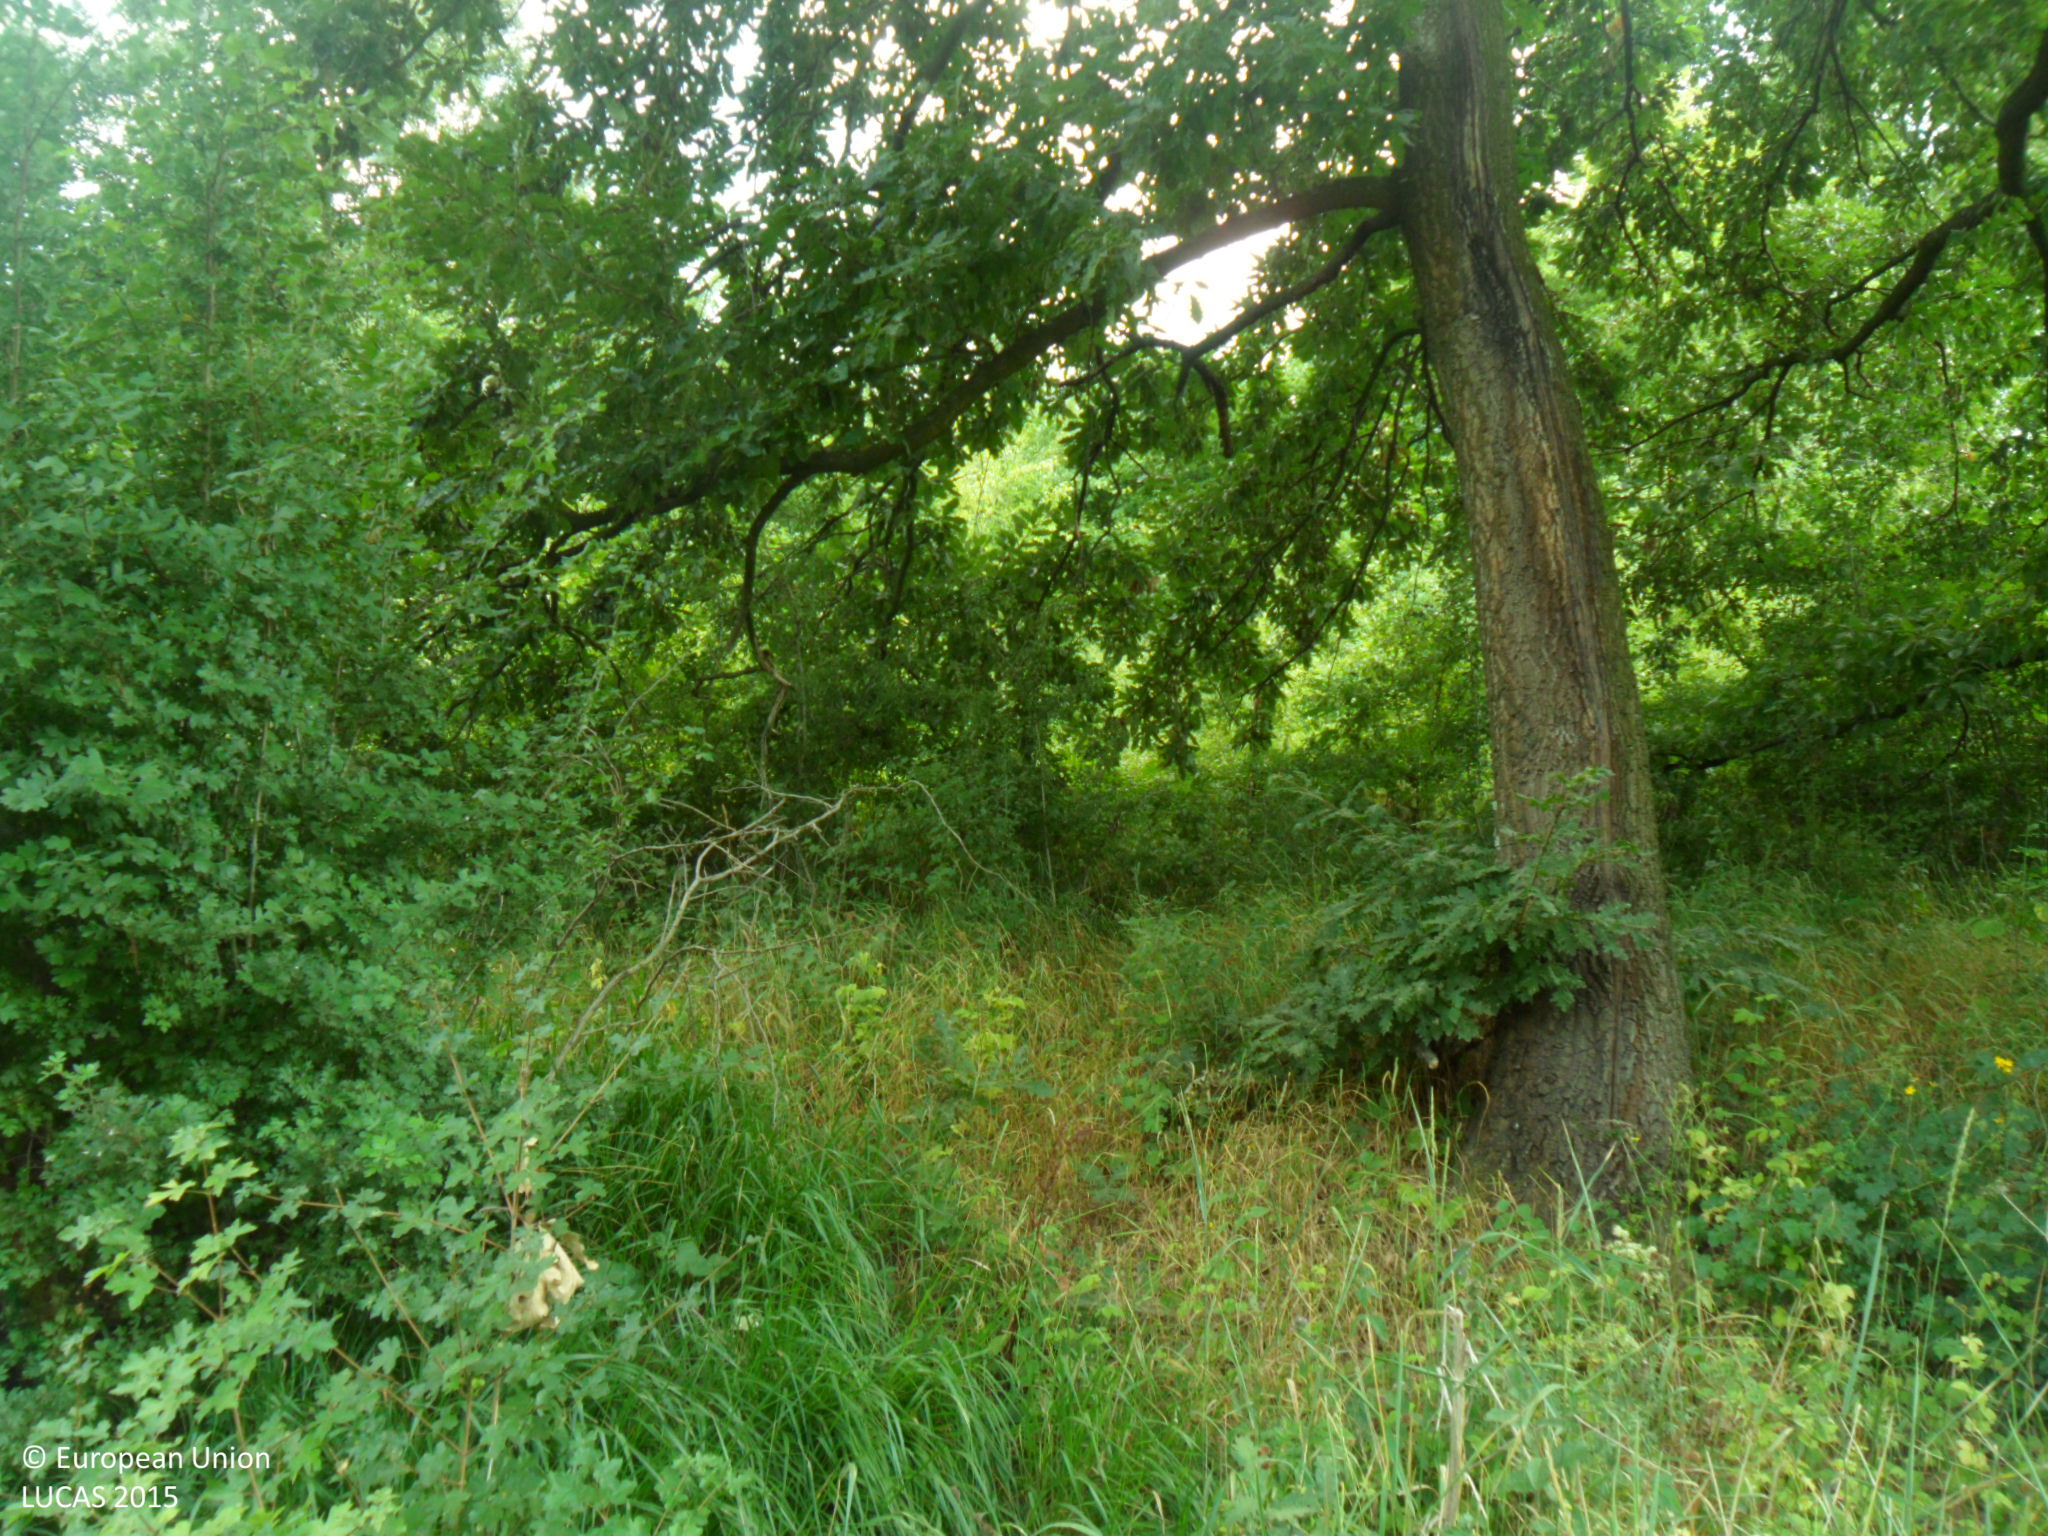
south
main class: Shrubland
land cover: Shrubland with sparse tree cover
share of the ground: > 75 %
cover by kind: shrubs 95 %, broadleaved forest trees 5 %
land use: Semi-natural and natural areas not in use
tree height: > 5 m
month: July
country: BG
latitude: 43.5821
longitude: 27.2017
